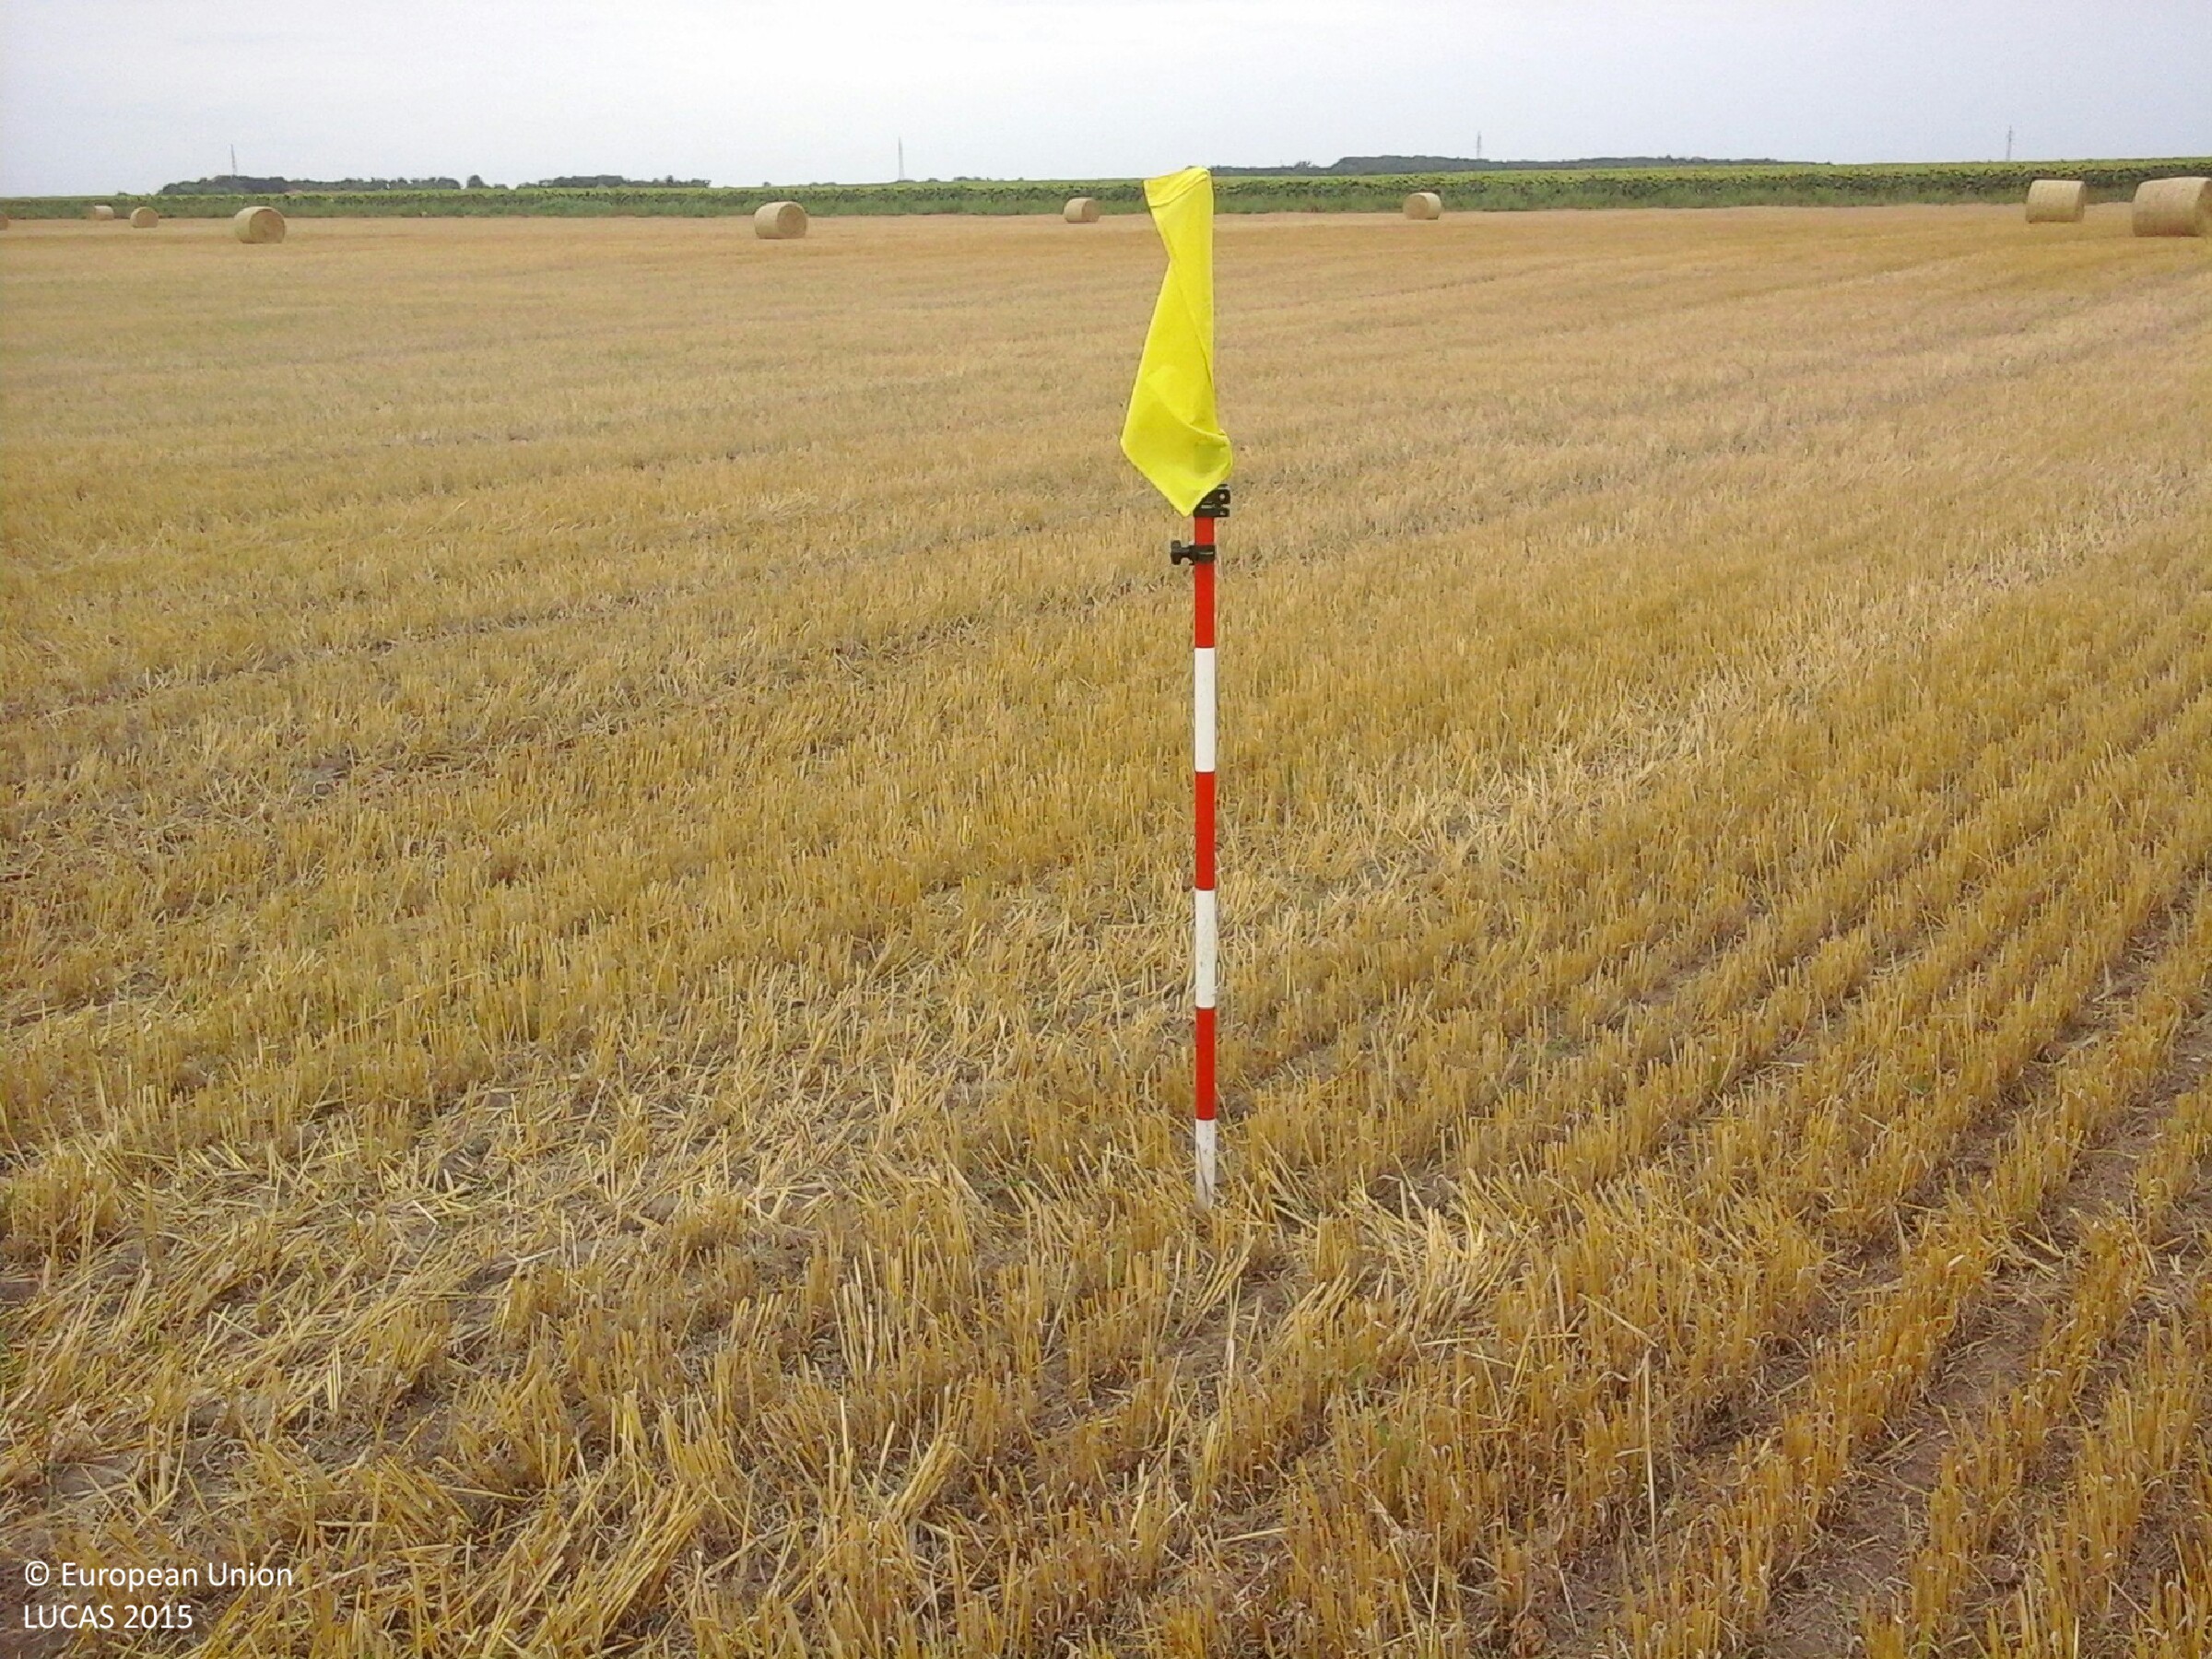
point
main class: Cropland
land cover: Common wheat
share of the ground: 25 - 50 %
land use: Agriculture (excluding fallow land and kitchen gardens)
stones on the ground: < 10 %
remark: Harvested field
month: July
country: HU
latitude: 47.4483
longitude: 20.8701
